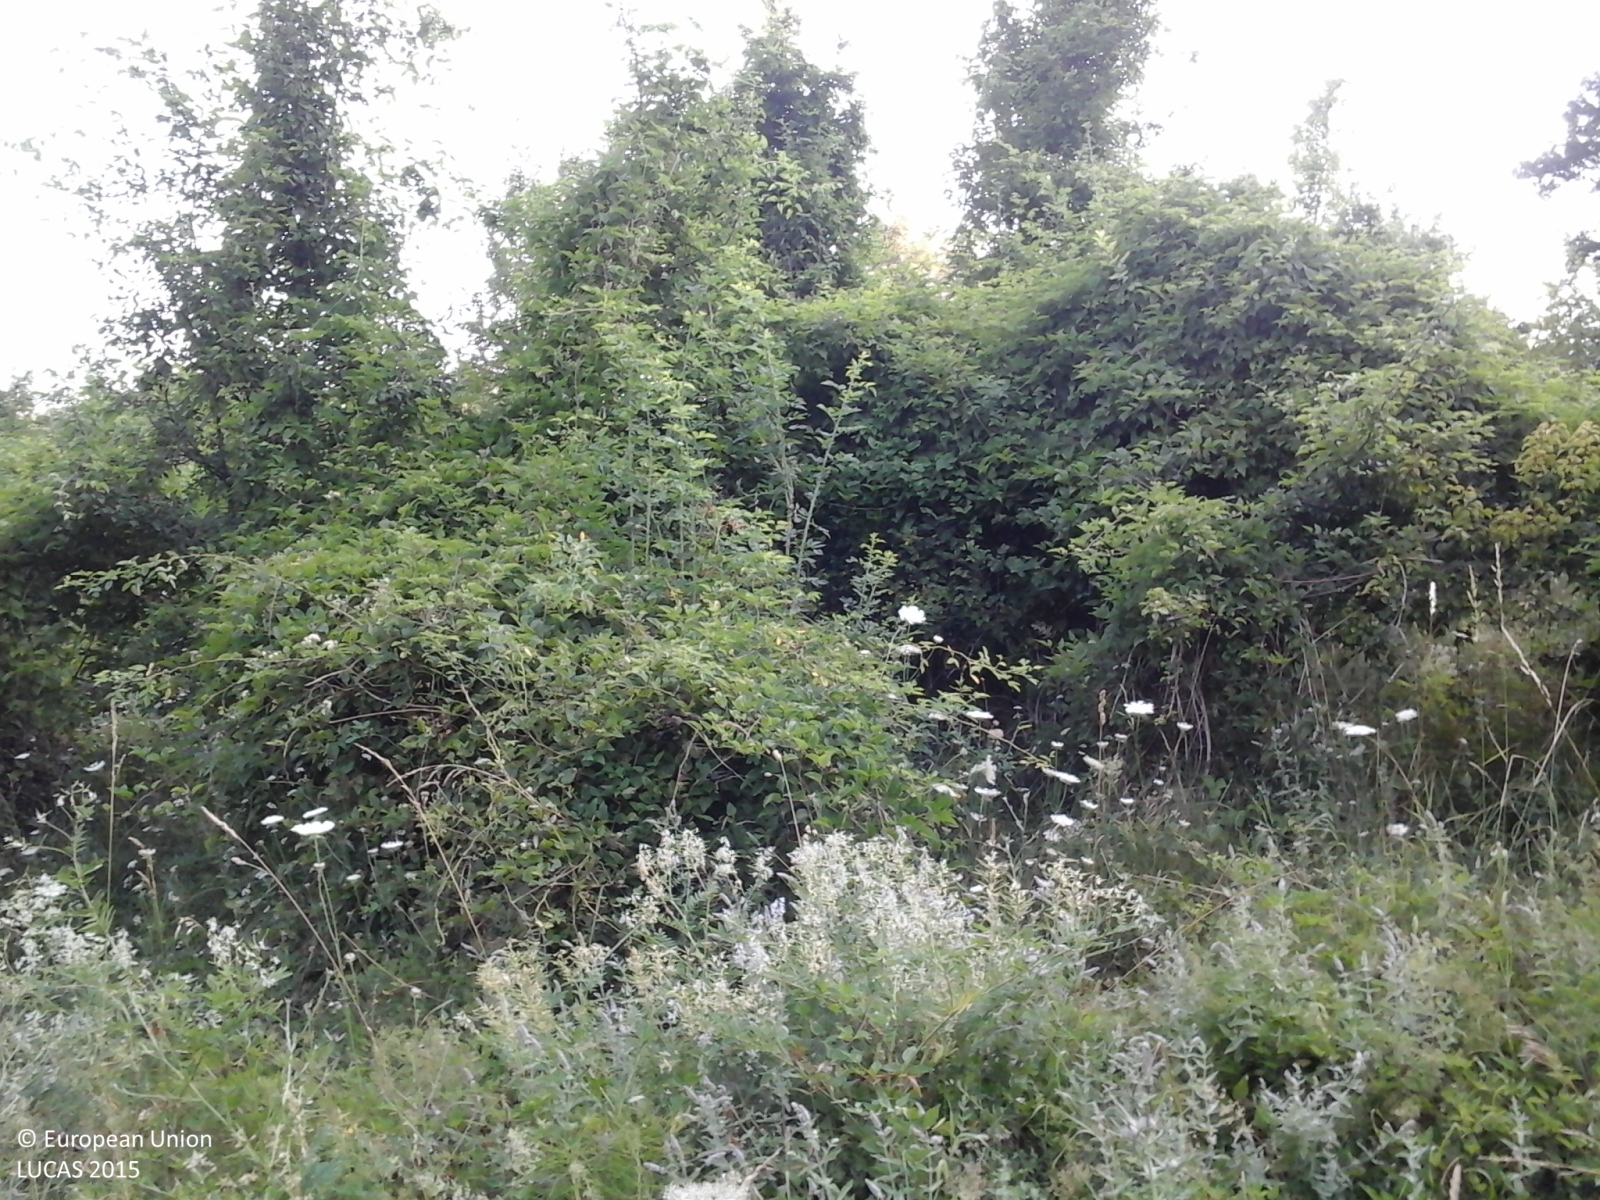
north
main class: Woodland
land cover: Broadleaved woodland
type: mesophytic deciduous forest
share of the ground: > 75 %
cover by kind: broadleaved forest trees 100 %
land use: Forestry
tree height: > 5 m
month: July
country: IT
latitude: 43.7520
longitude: 12.0936
